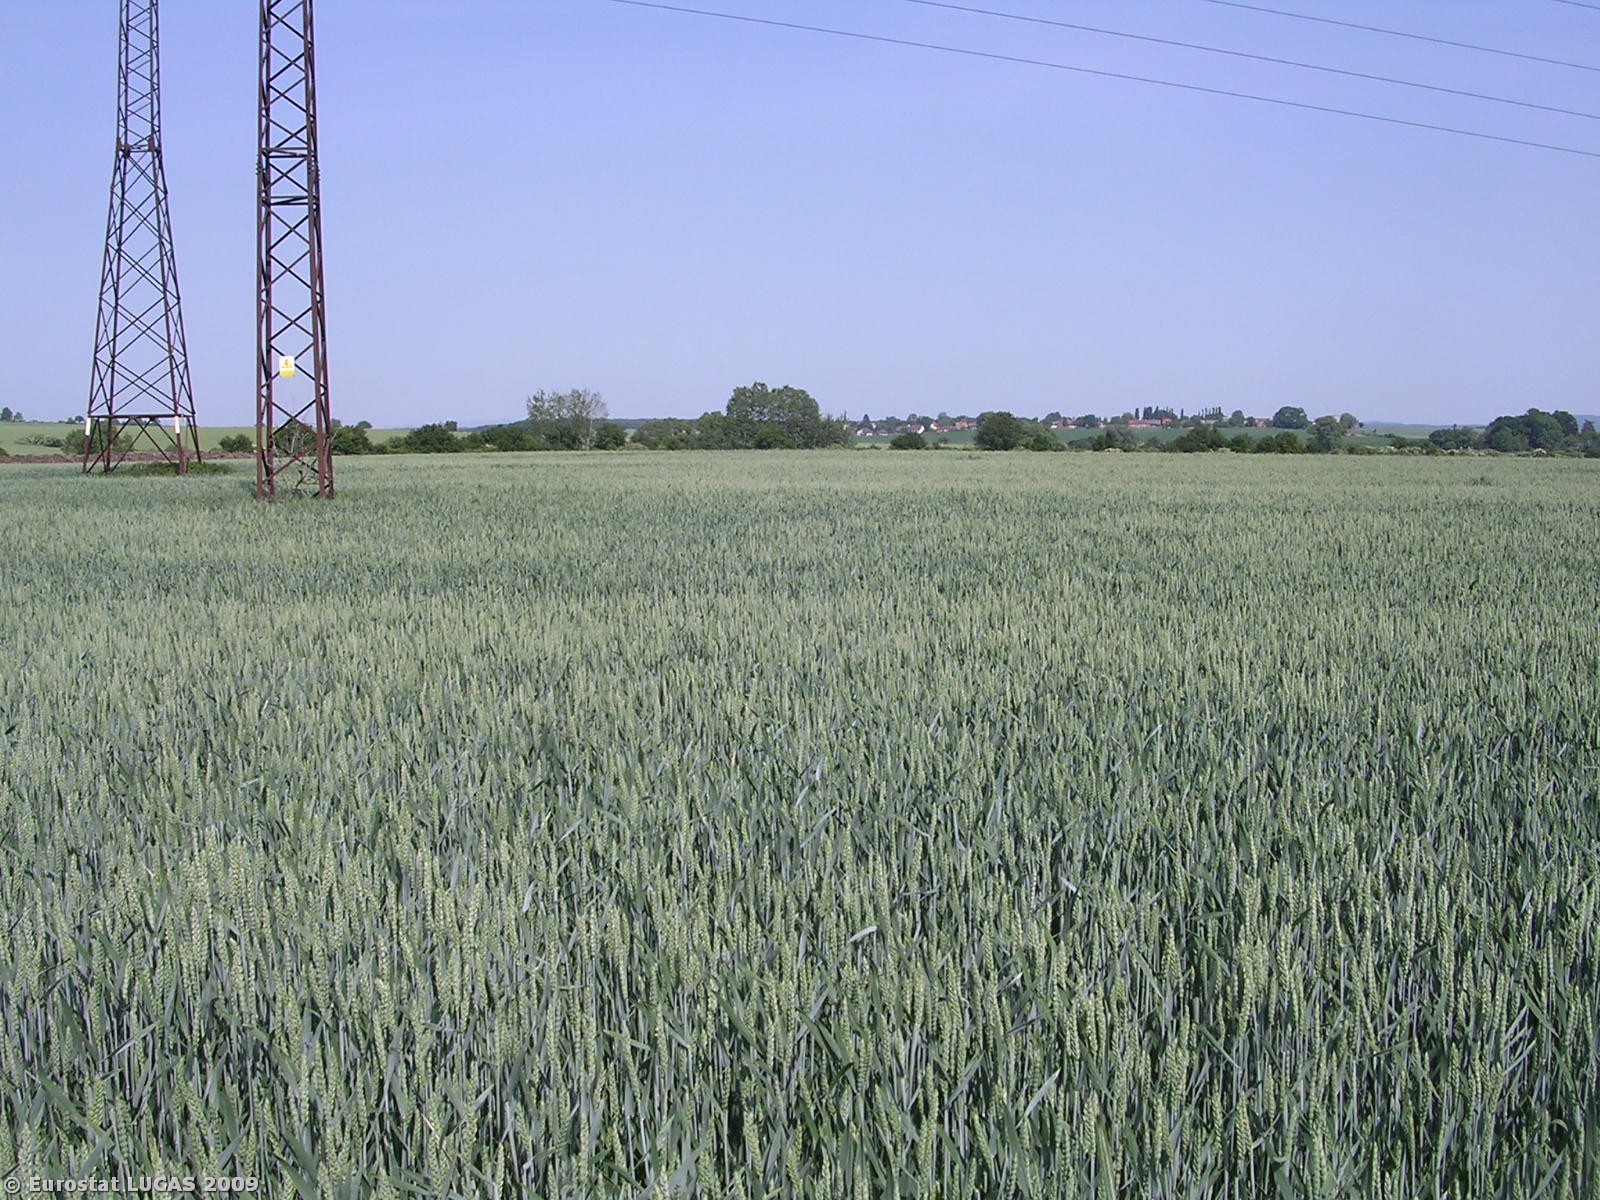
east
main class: Cropland
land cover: Common wheat
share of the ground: > 75 %
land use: Agriculture (excluding fallow land and kitchen gardens)
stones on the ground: < 10 %
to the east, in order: Common wheat; Electric lines; Common wheat; Electric lines; Common wheat
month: May
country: CZ
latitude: 50.4373
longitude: 14.9447
